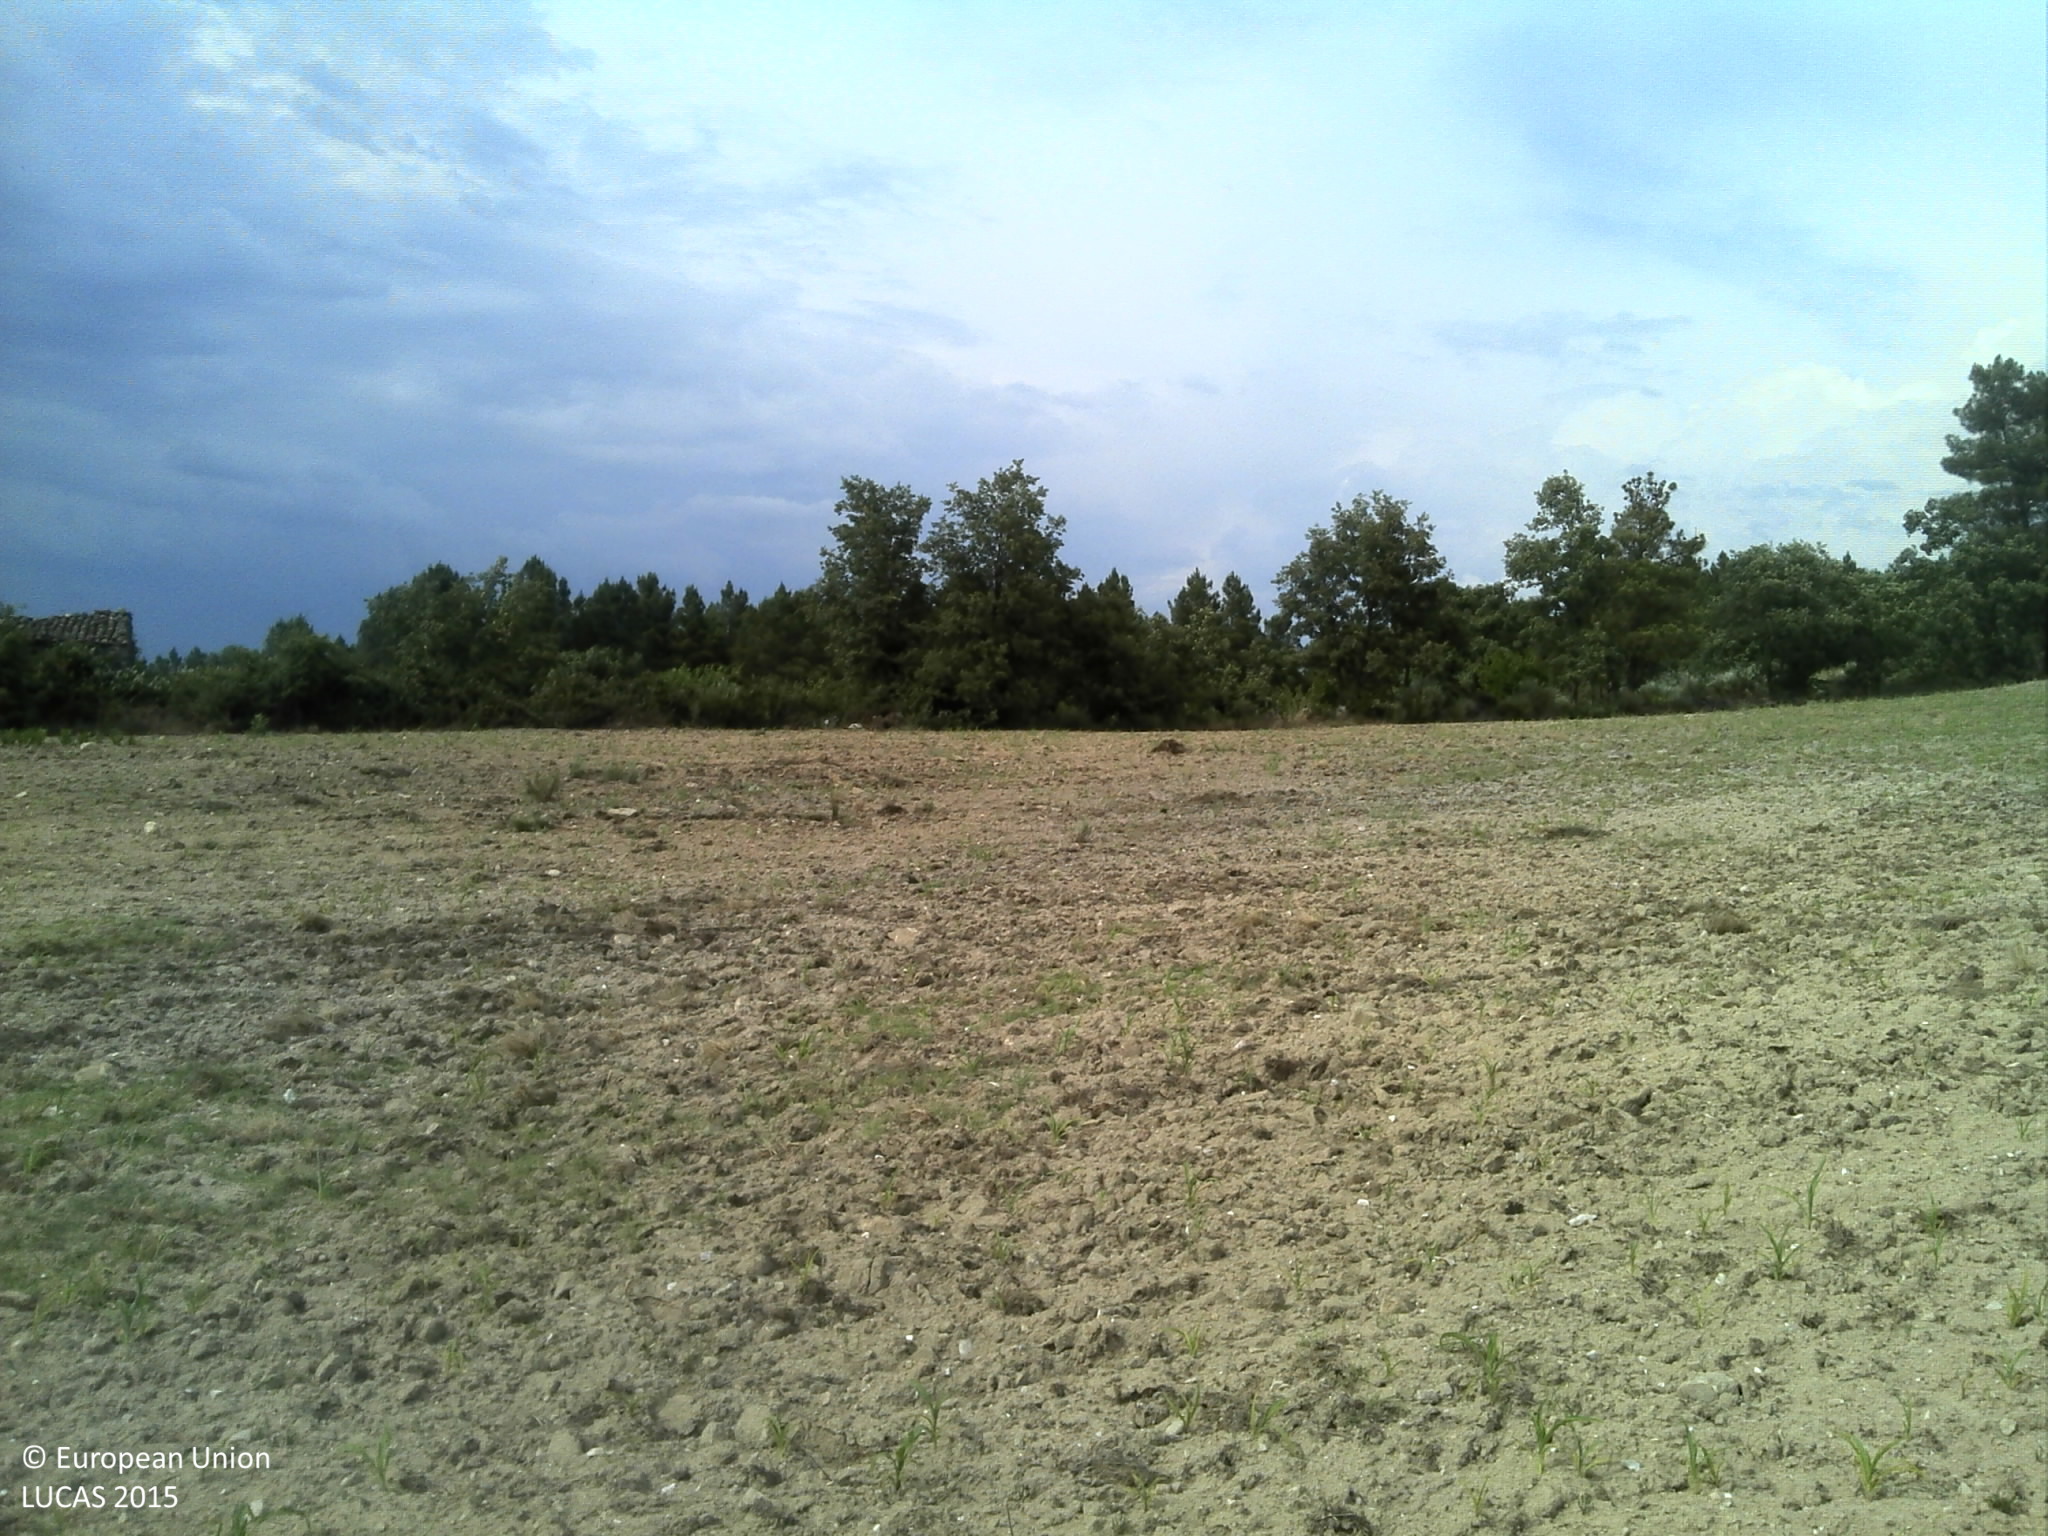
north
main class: Cropland
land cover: Maize
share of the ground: < 10 %
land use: Agriculture (excluding fallow land and kitchen gardens)
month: June
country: PT
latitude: 40.2712
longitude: -7.3794
